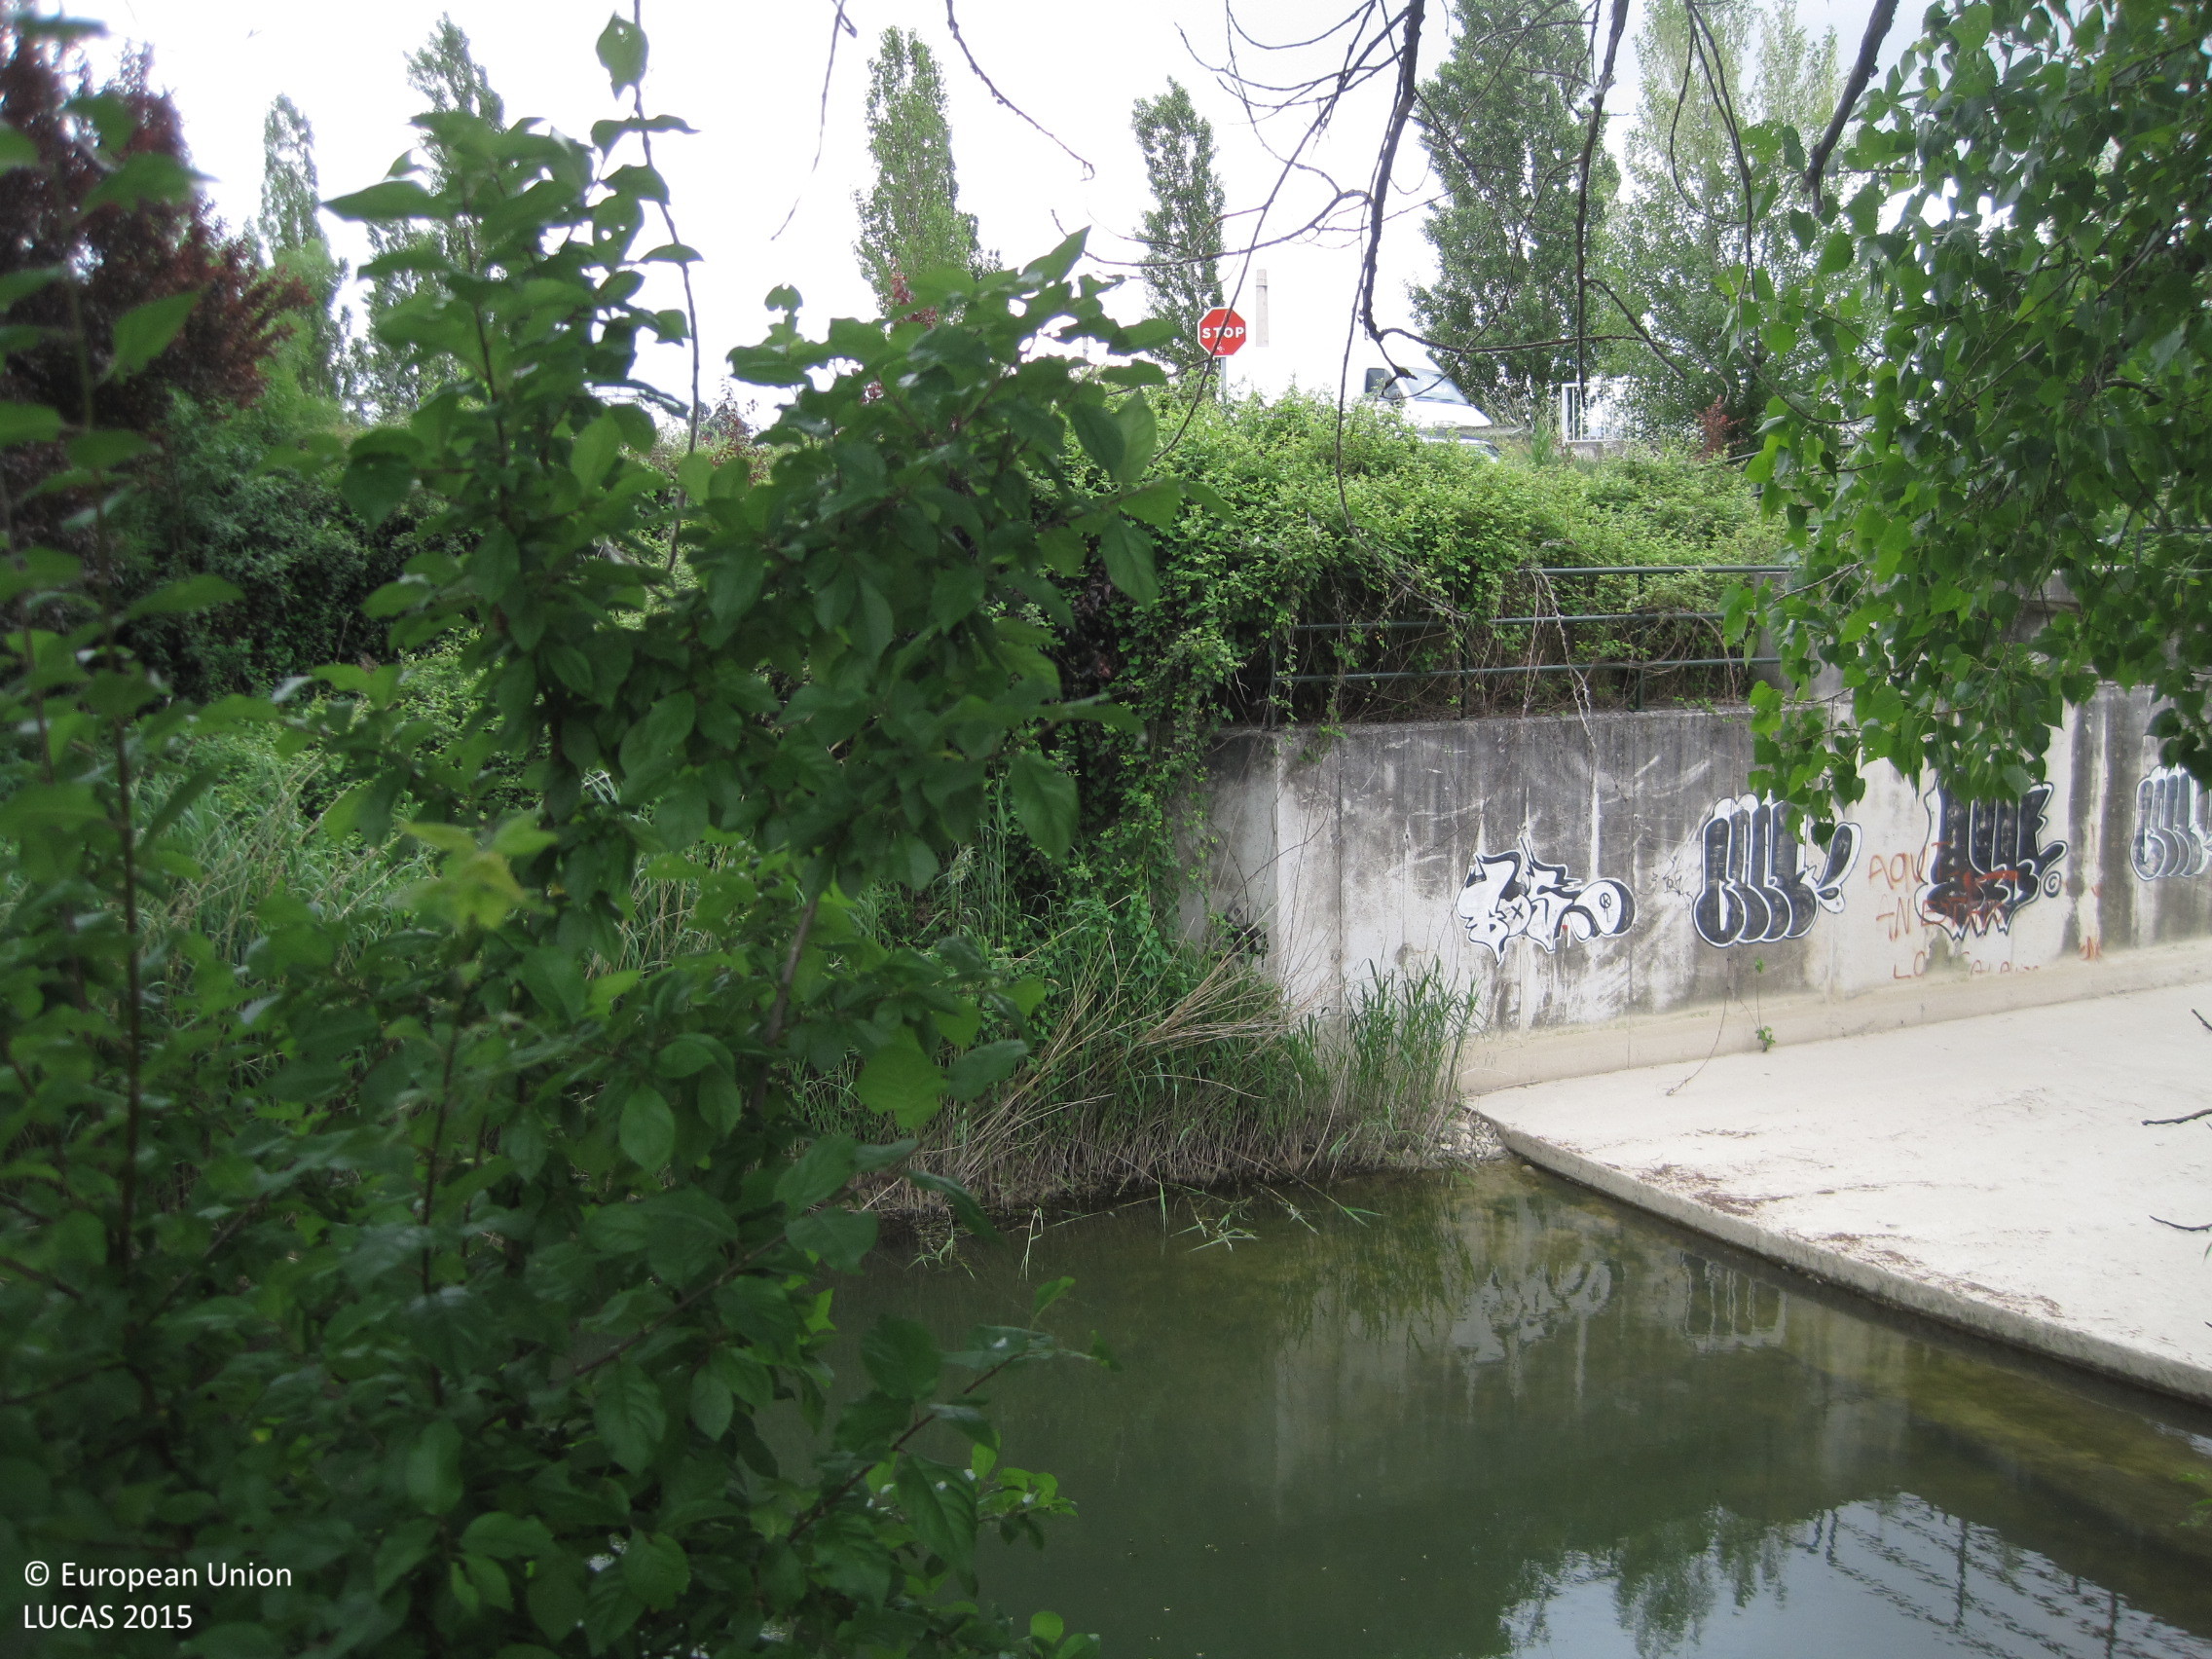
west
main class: Woodland
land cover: Broadleaved woodland
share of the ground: > 75 %
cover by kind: broadleaved forest trees 100 %
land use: Semi-natural and natural areas not in use
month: May
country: ES
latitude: 42.7975
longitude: -1.6667
